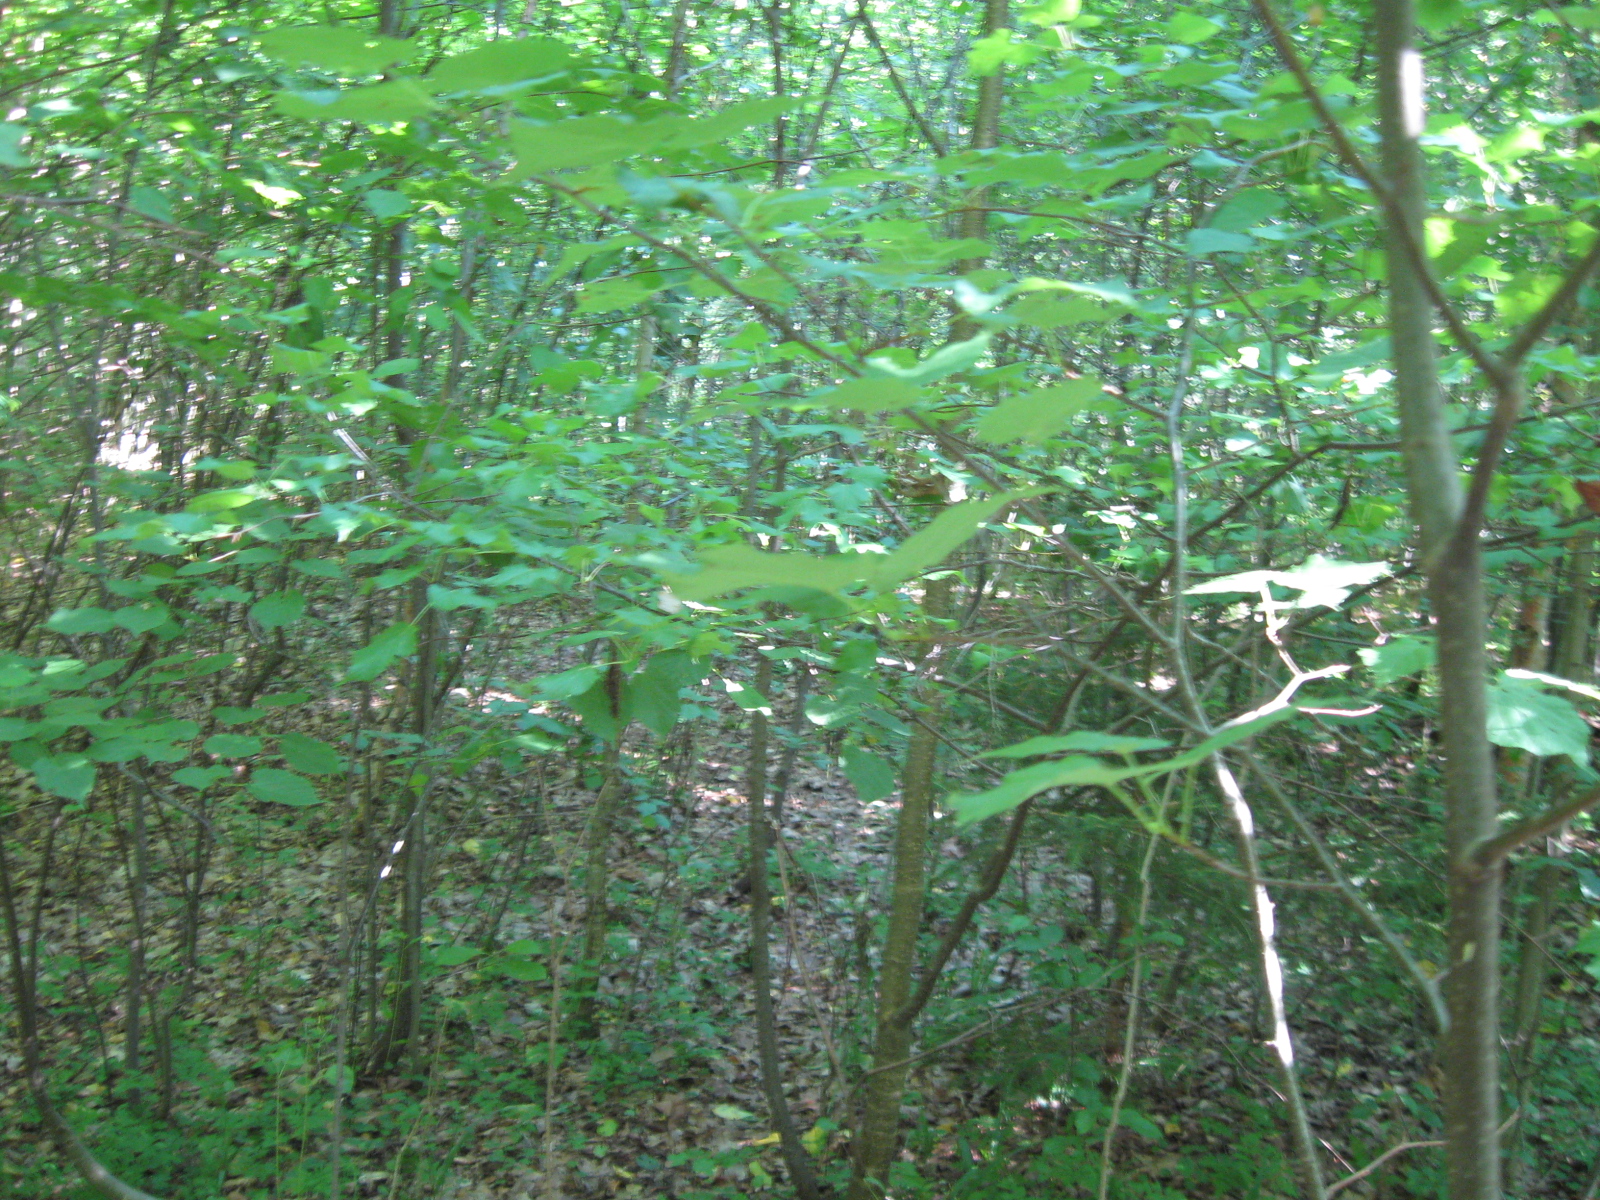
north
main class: Woodland
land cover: Broadleaved woodland
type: non-riverine alder, birch or aspen forest
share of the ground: > 75 %
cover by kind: broadleaved forest trees 90 %, herbaceous plants 10 %
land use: Forestry
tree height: > 5 m
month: July
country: LT
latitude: 54.7744
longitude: 23.8462
